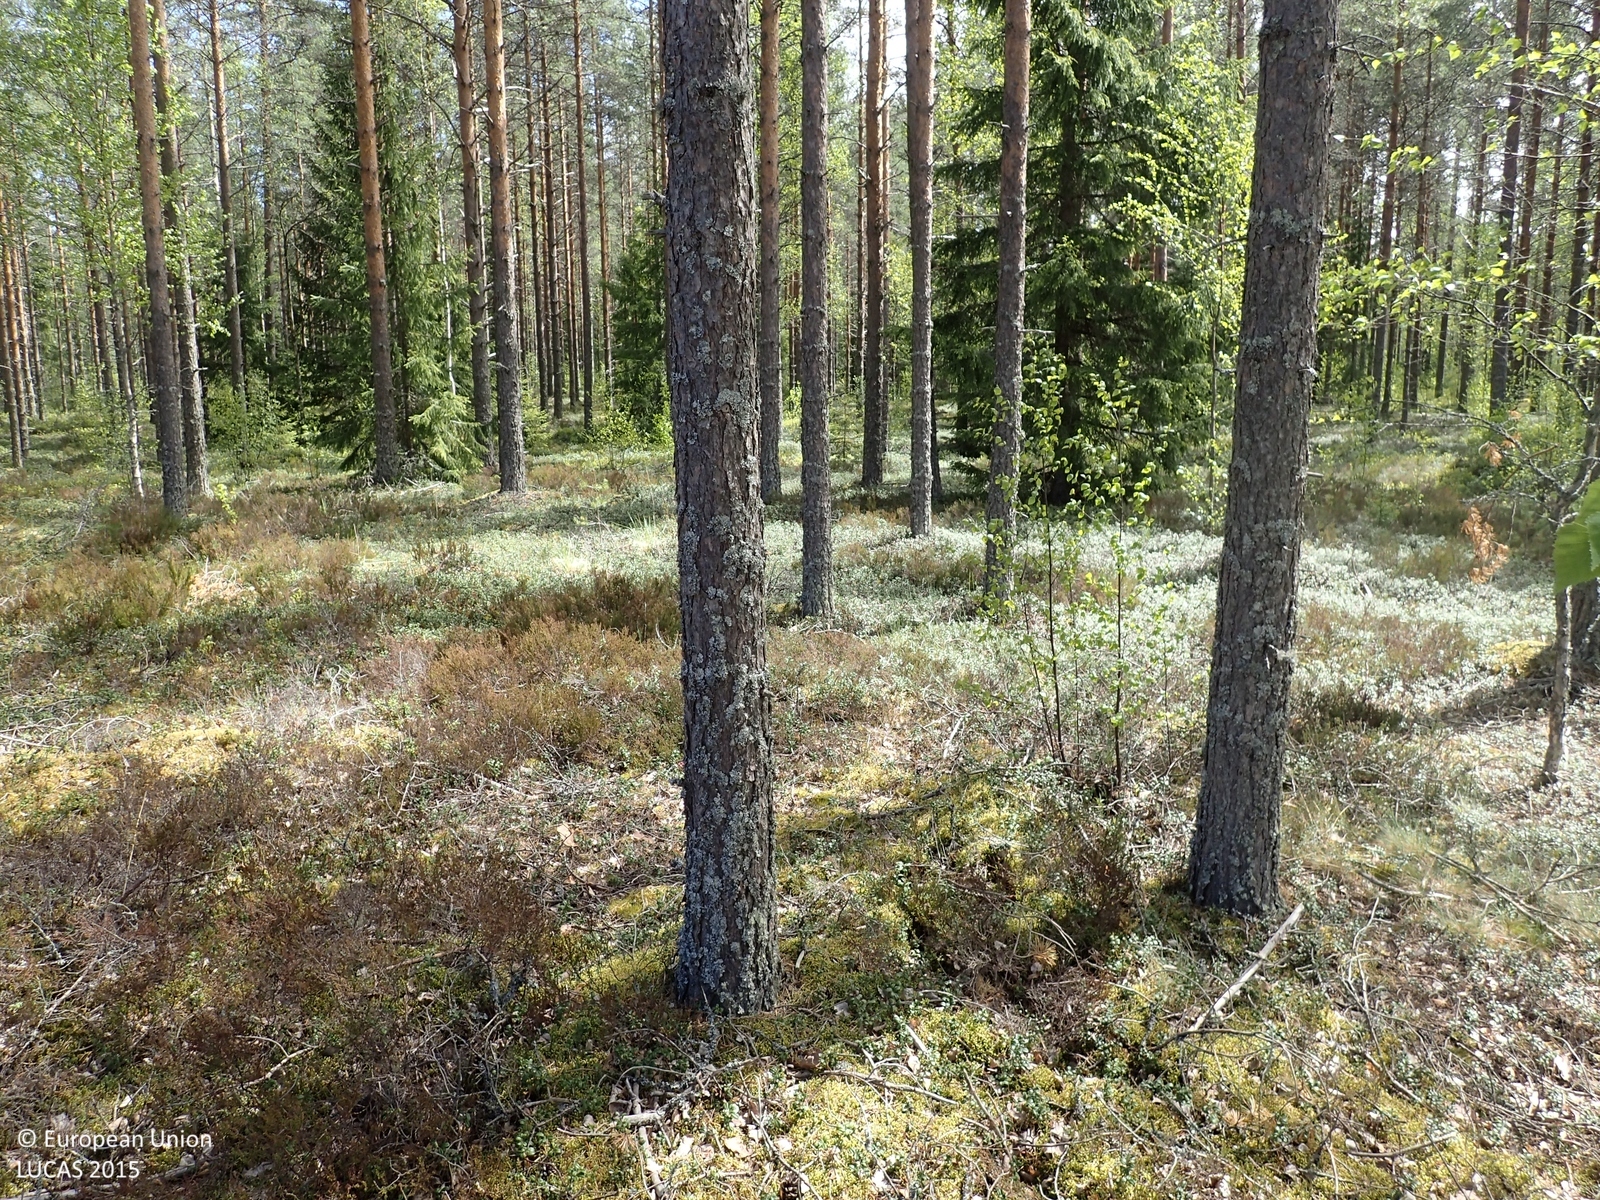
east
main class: Woodland
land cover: Pine dominated coniferous woodland
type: boreal forest
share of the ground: > 75 %
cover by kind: coniferous forest trees 65 %, shrubs 20 %, broadleaved forest trees 10 %, lichens and mosses 5 %
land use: Forestry
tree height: > 5 m
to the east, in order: Pine dominated coniferous woodland; Ditches and canals; Pine dominated coniferous woodland
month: June
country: FI
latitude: 62.1798
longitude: 22.2903
